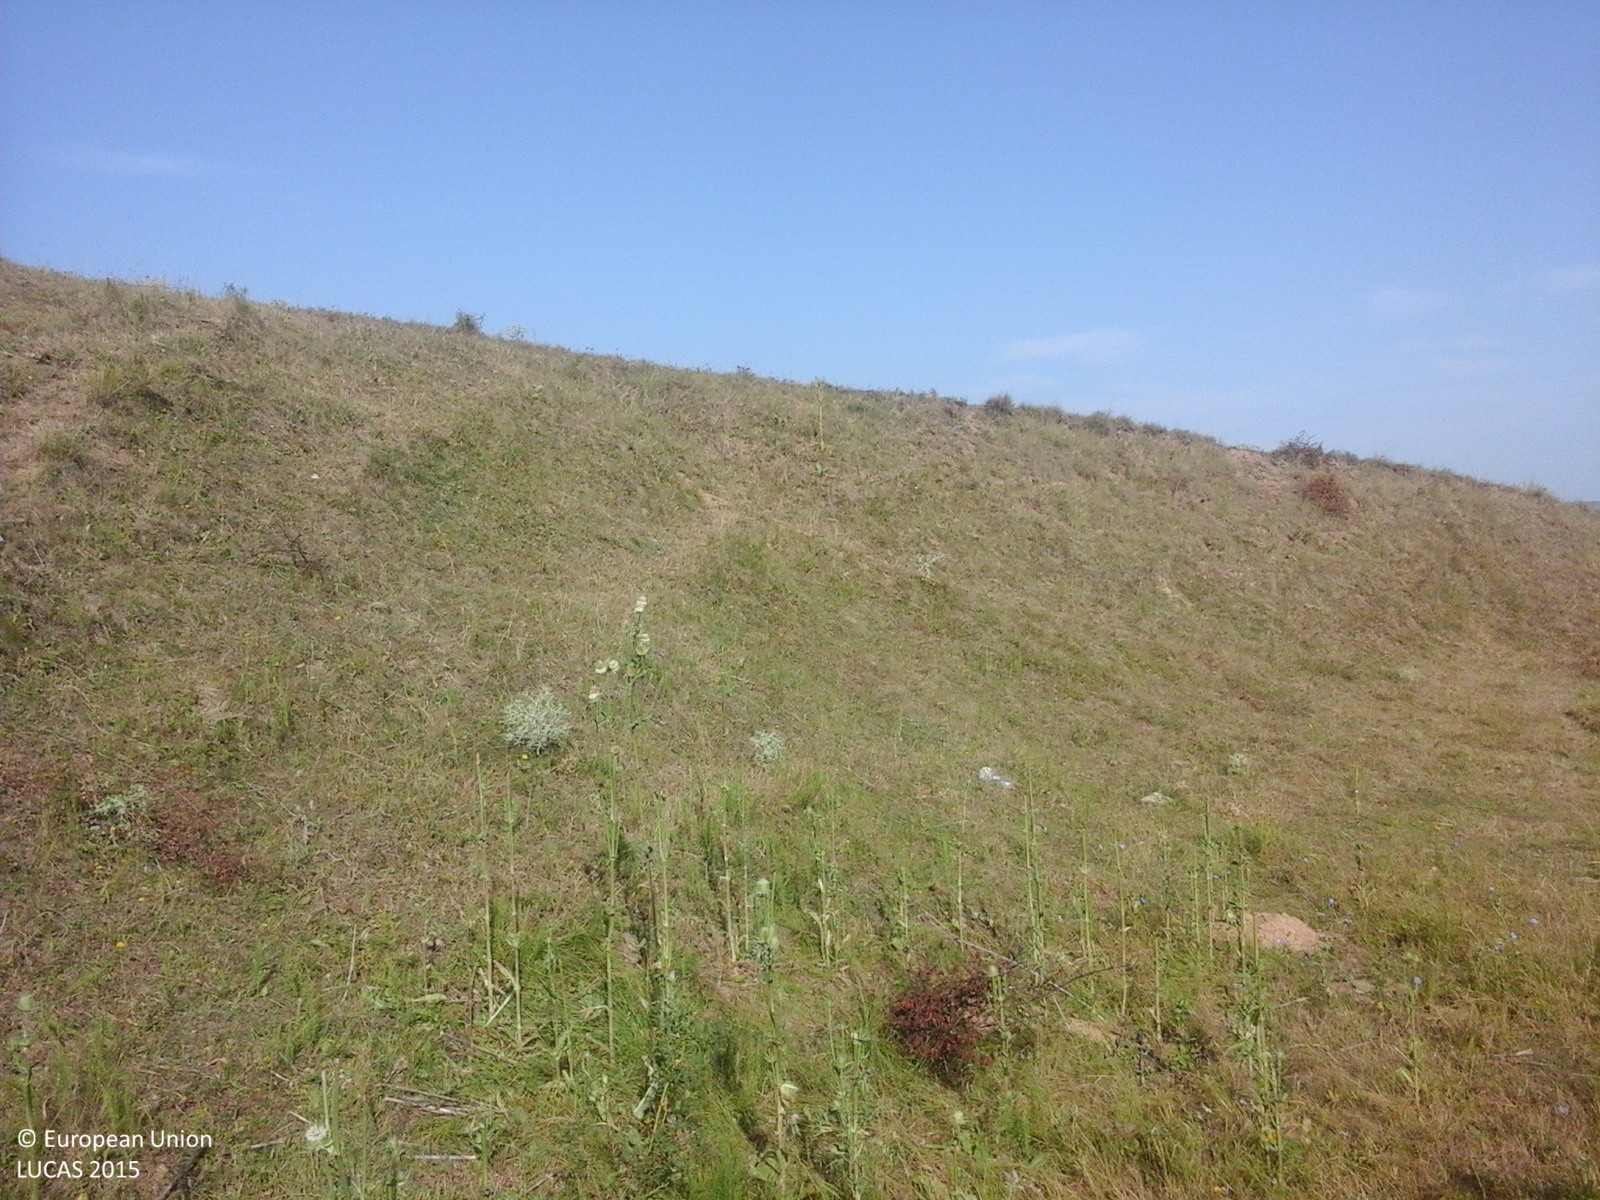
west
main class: Grassland
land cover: Grassland without tree/shrub cover
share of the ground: > 75 %
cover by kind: herbaceous plants 100 %
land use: Agriculture (excluding fallow land and kitchen gardens)
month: July
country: RO
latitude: 46.2111
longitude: 27.3295
